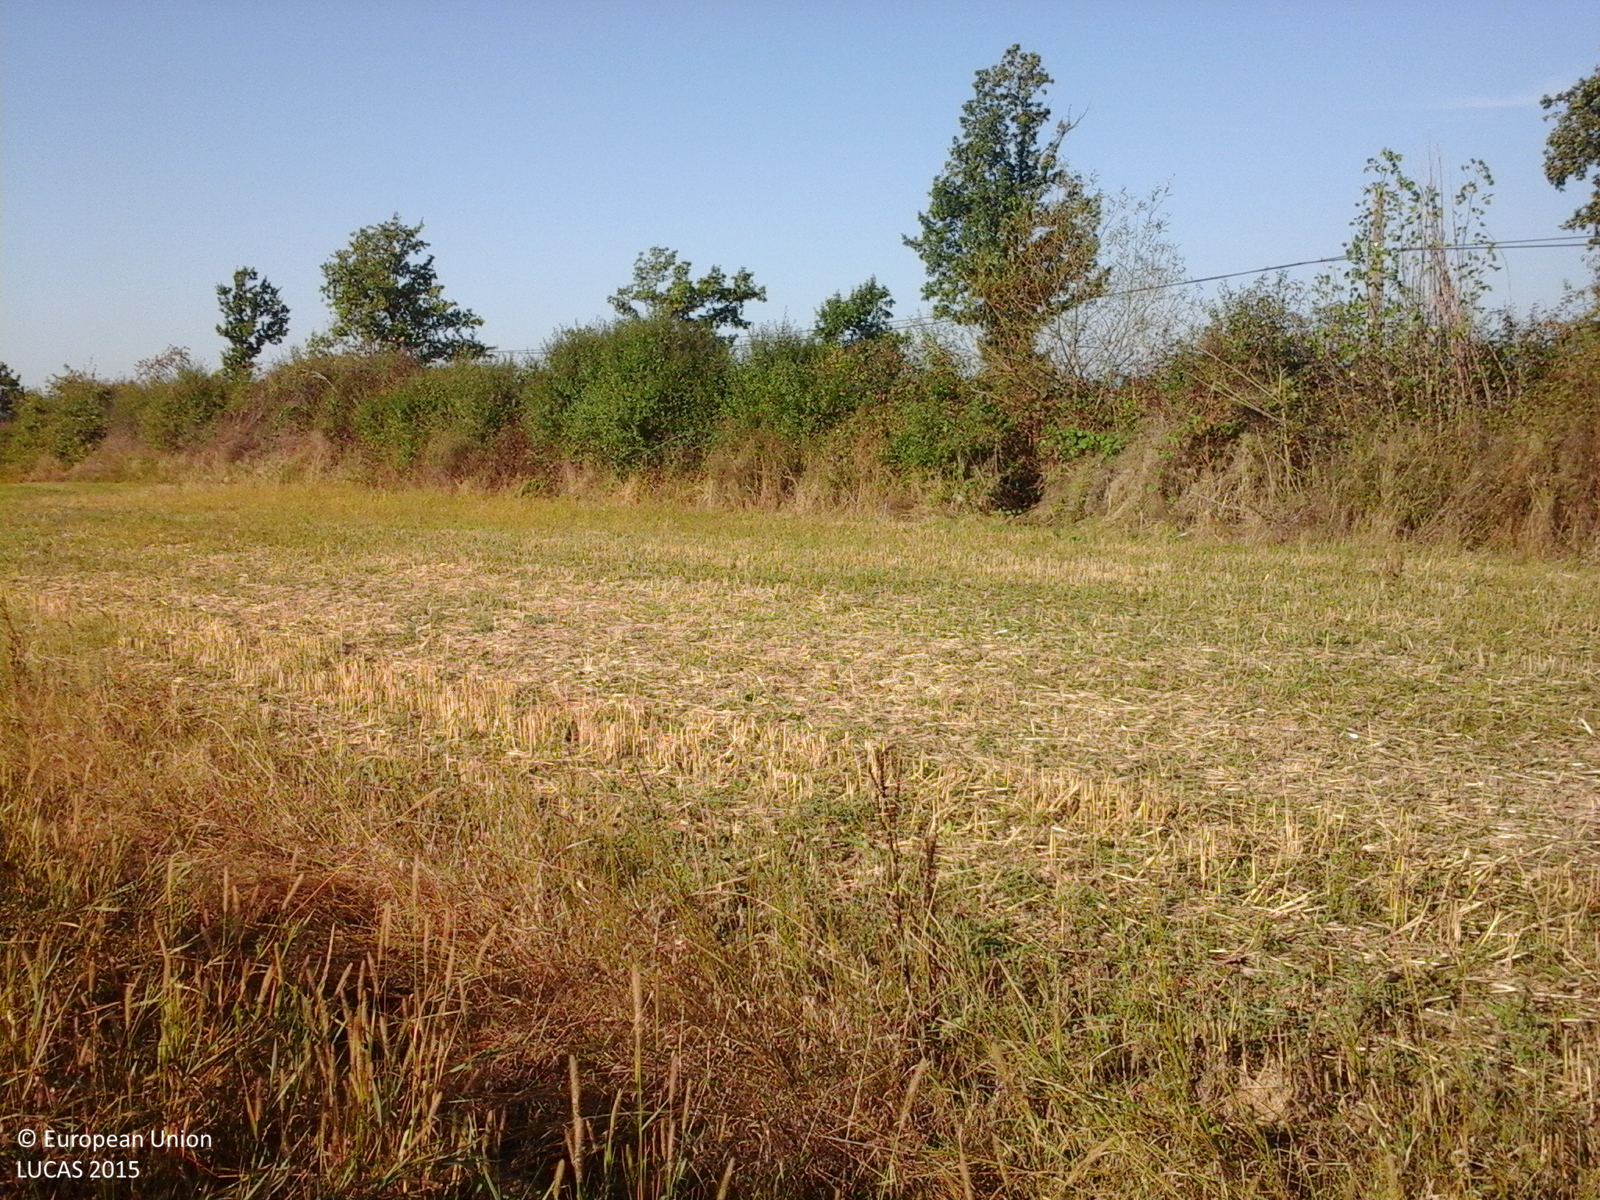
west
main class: Cropland
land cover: Maize
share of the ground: > 75 %
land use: Agriculture (excluding fallow land and kitchen gardens)
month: September
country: RO
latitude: 46.6022
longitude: 22.4666
